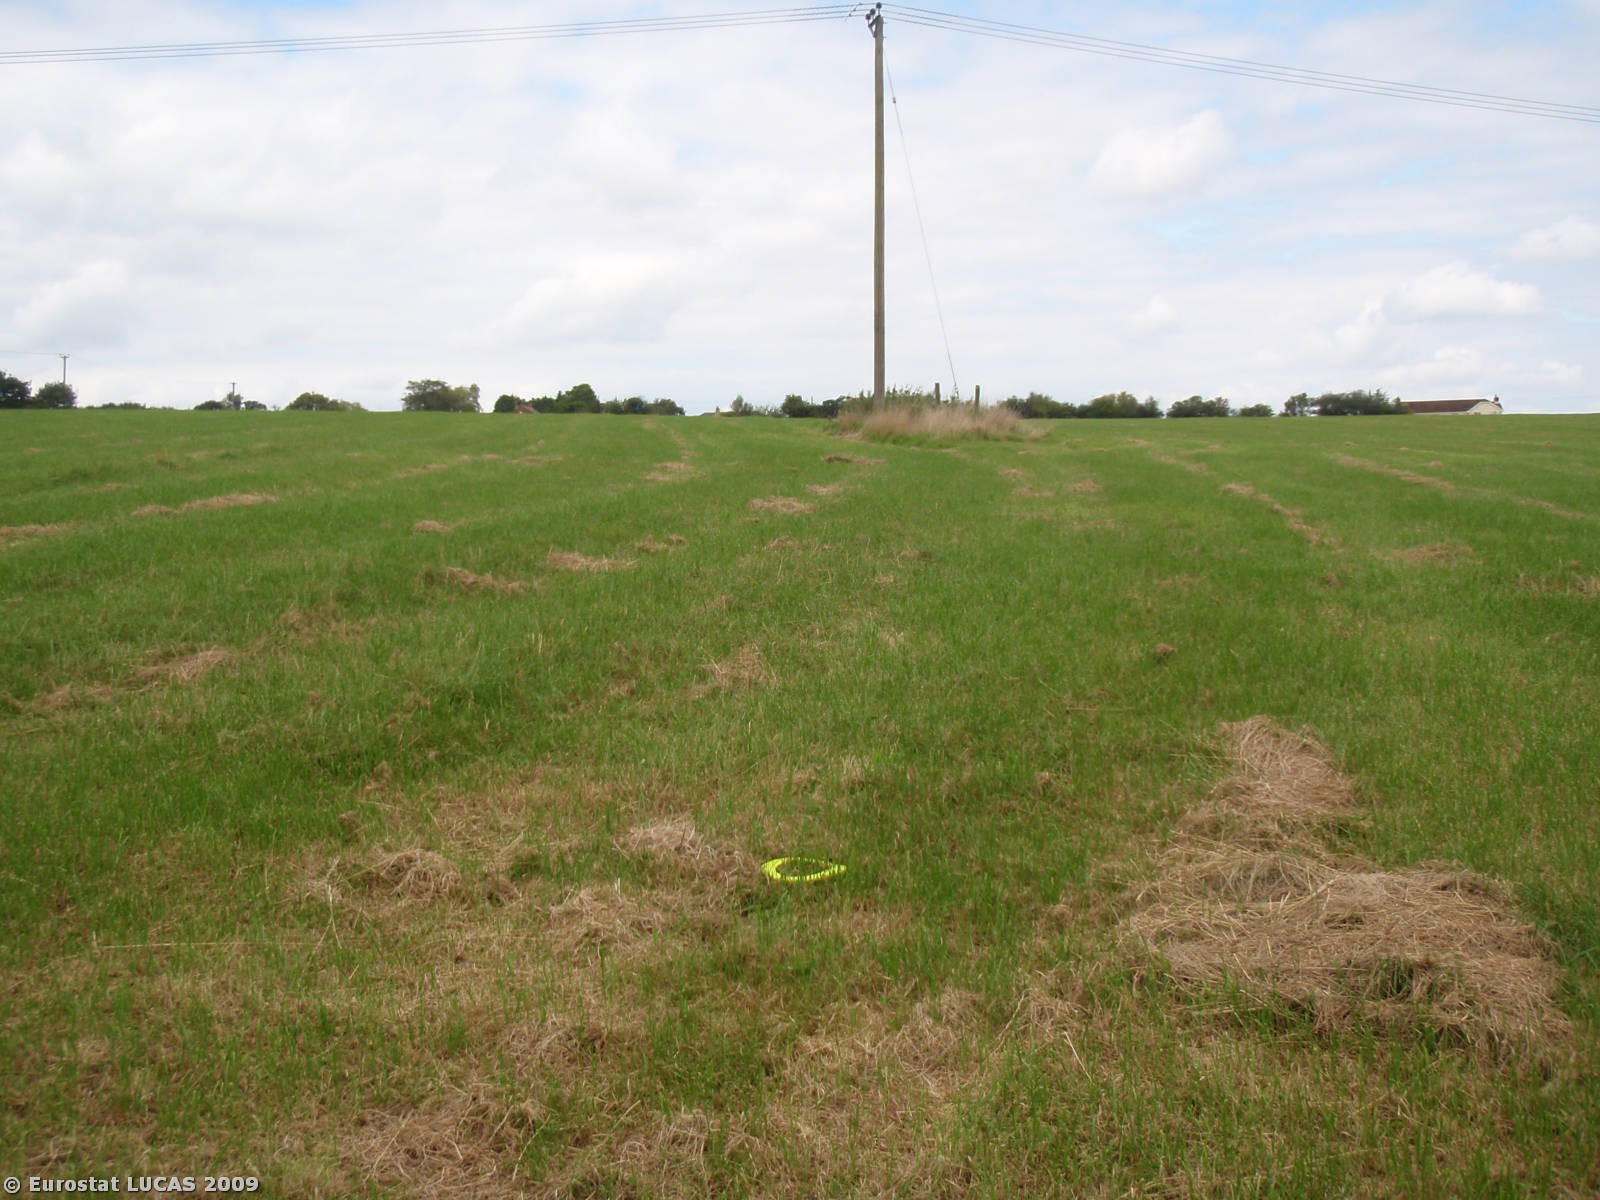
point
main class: Grassland
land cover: Grassland without tree/shrub cover
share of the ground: > 75 %
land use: Agriculture (excluding fallow land and kitchen gardens)
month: August
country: GB
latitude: 50.7590
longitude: -2.0664
